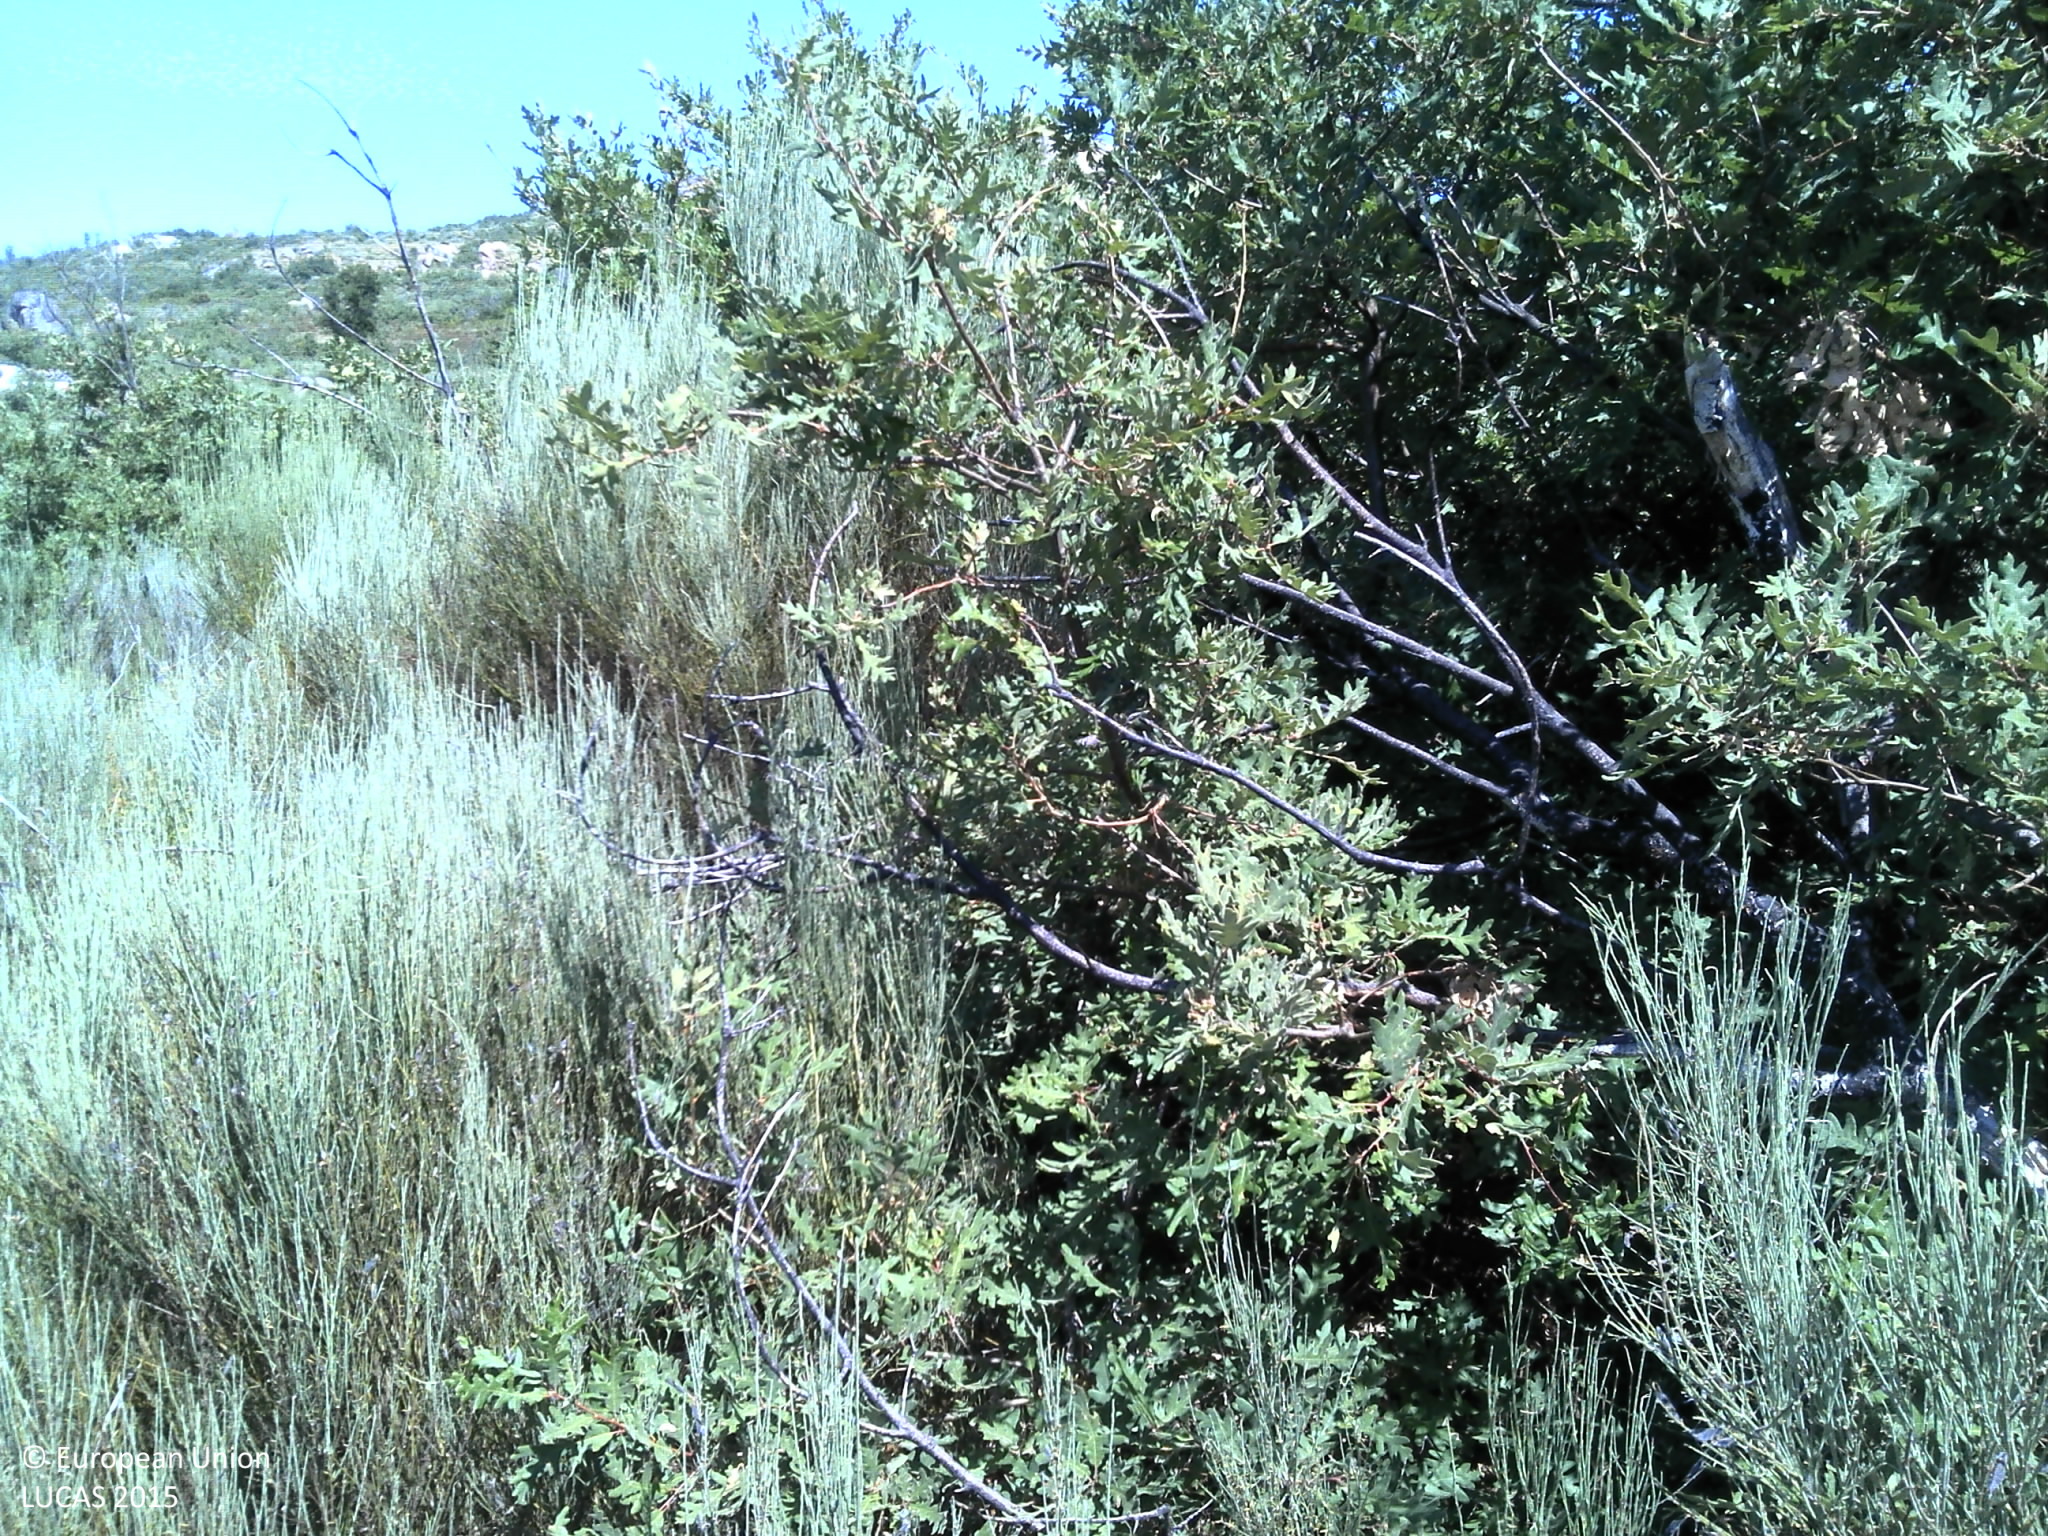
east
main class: Shrubland
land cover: Shrubland with sparse tree cover
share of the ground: > 75 %
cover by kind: shrubs 75 %, herbaceous plants 15 %, broadleaved forest trees 5 %, consolidated bare surface 5 %
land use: Agriculture (excluding fallow land and kitchen gardens)
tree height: < 5 m
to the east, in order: Shrubland with sparse tree cover; Dry stone walls; Shrubland with sparse tree cover; Dry stone walls; Shrubland with sparse tree cover; Tracks; Shrubland without tree cover; Dry stone walls; Shrubland with sparse tree cover; Rocks and stones; Shrubland with sparse tree cover
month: July
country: PT
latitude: 41.7514
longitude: -7.5585
